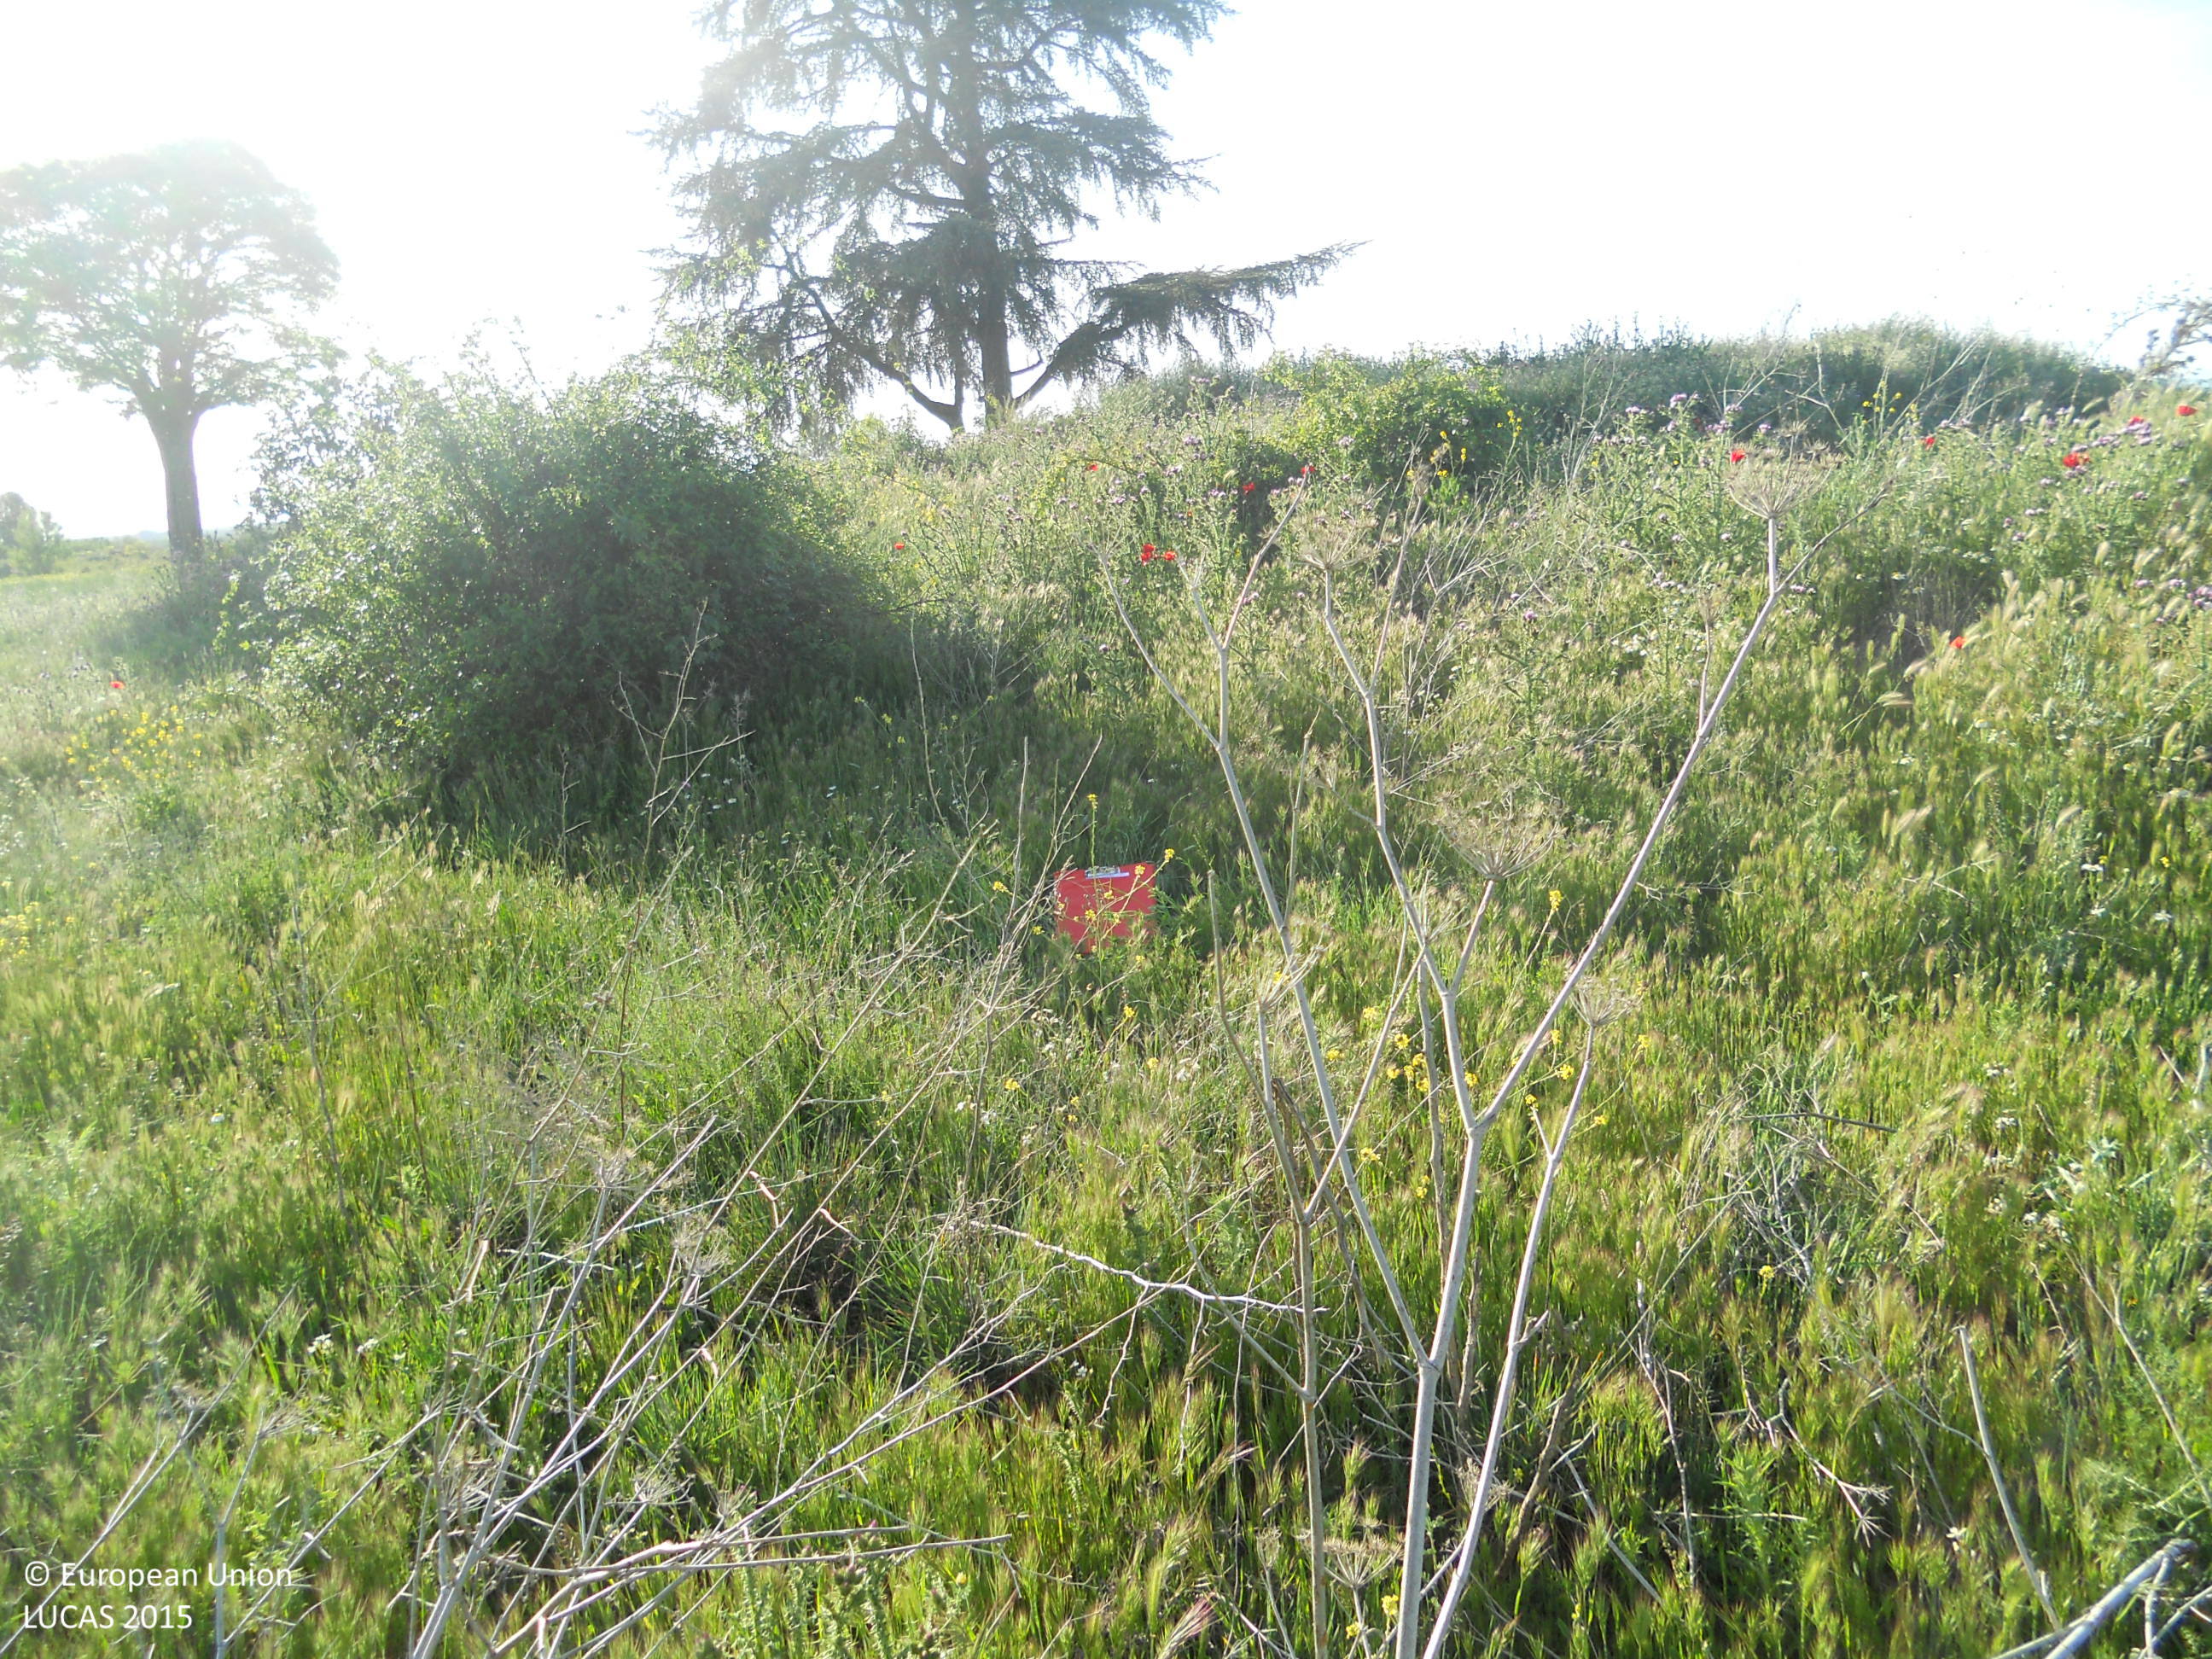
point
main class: Grassland
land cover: Grassland with sparse tree/shrub cover
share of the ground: > 75 %
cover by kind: herbaceous plants 95 %, broadleaved forest trees 5 %
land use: Semi-natural and natural areas not in use
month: May
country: ES
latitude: 42.3131
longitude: -5.5127
